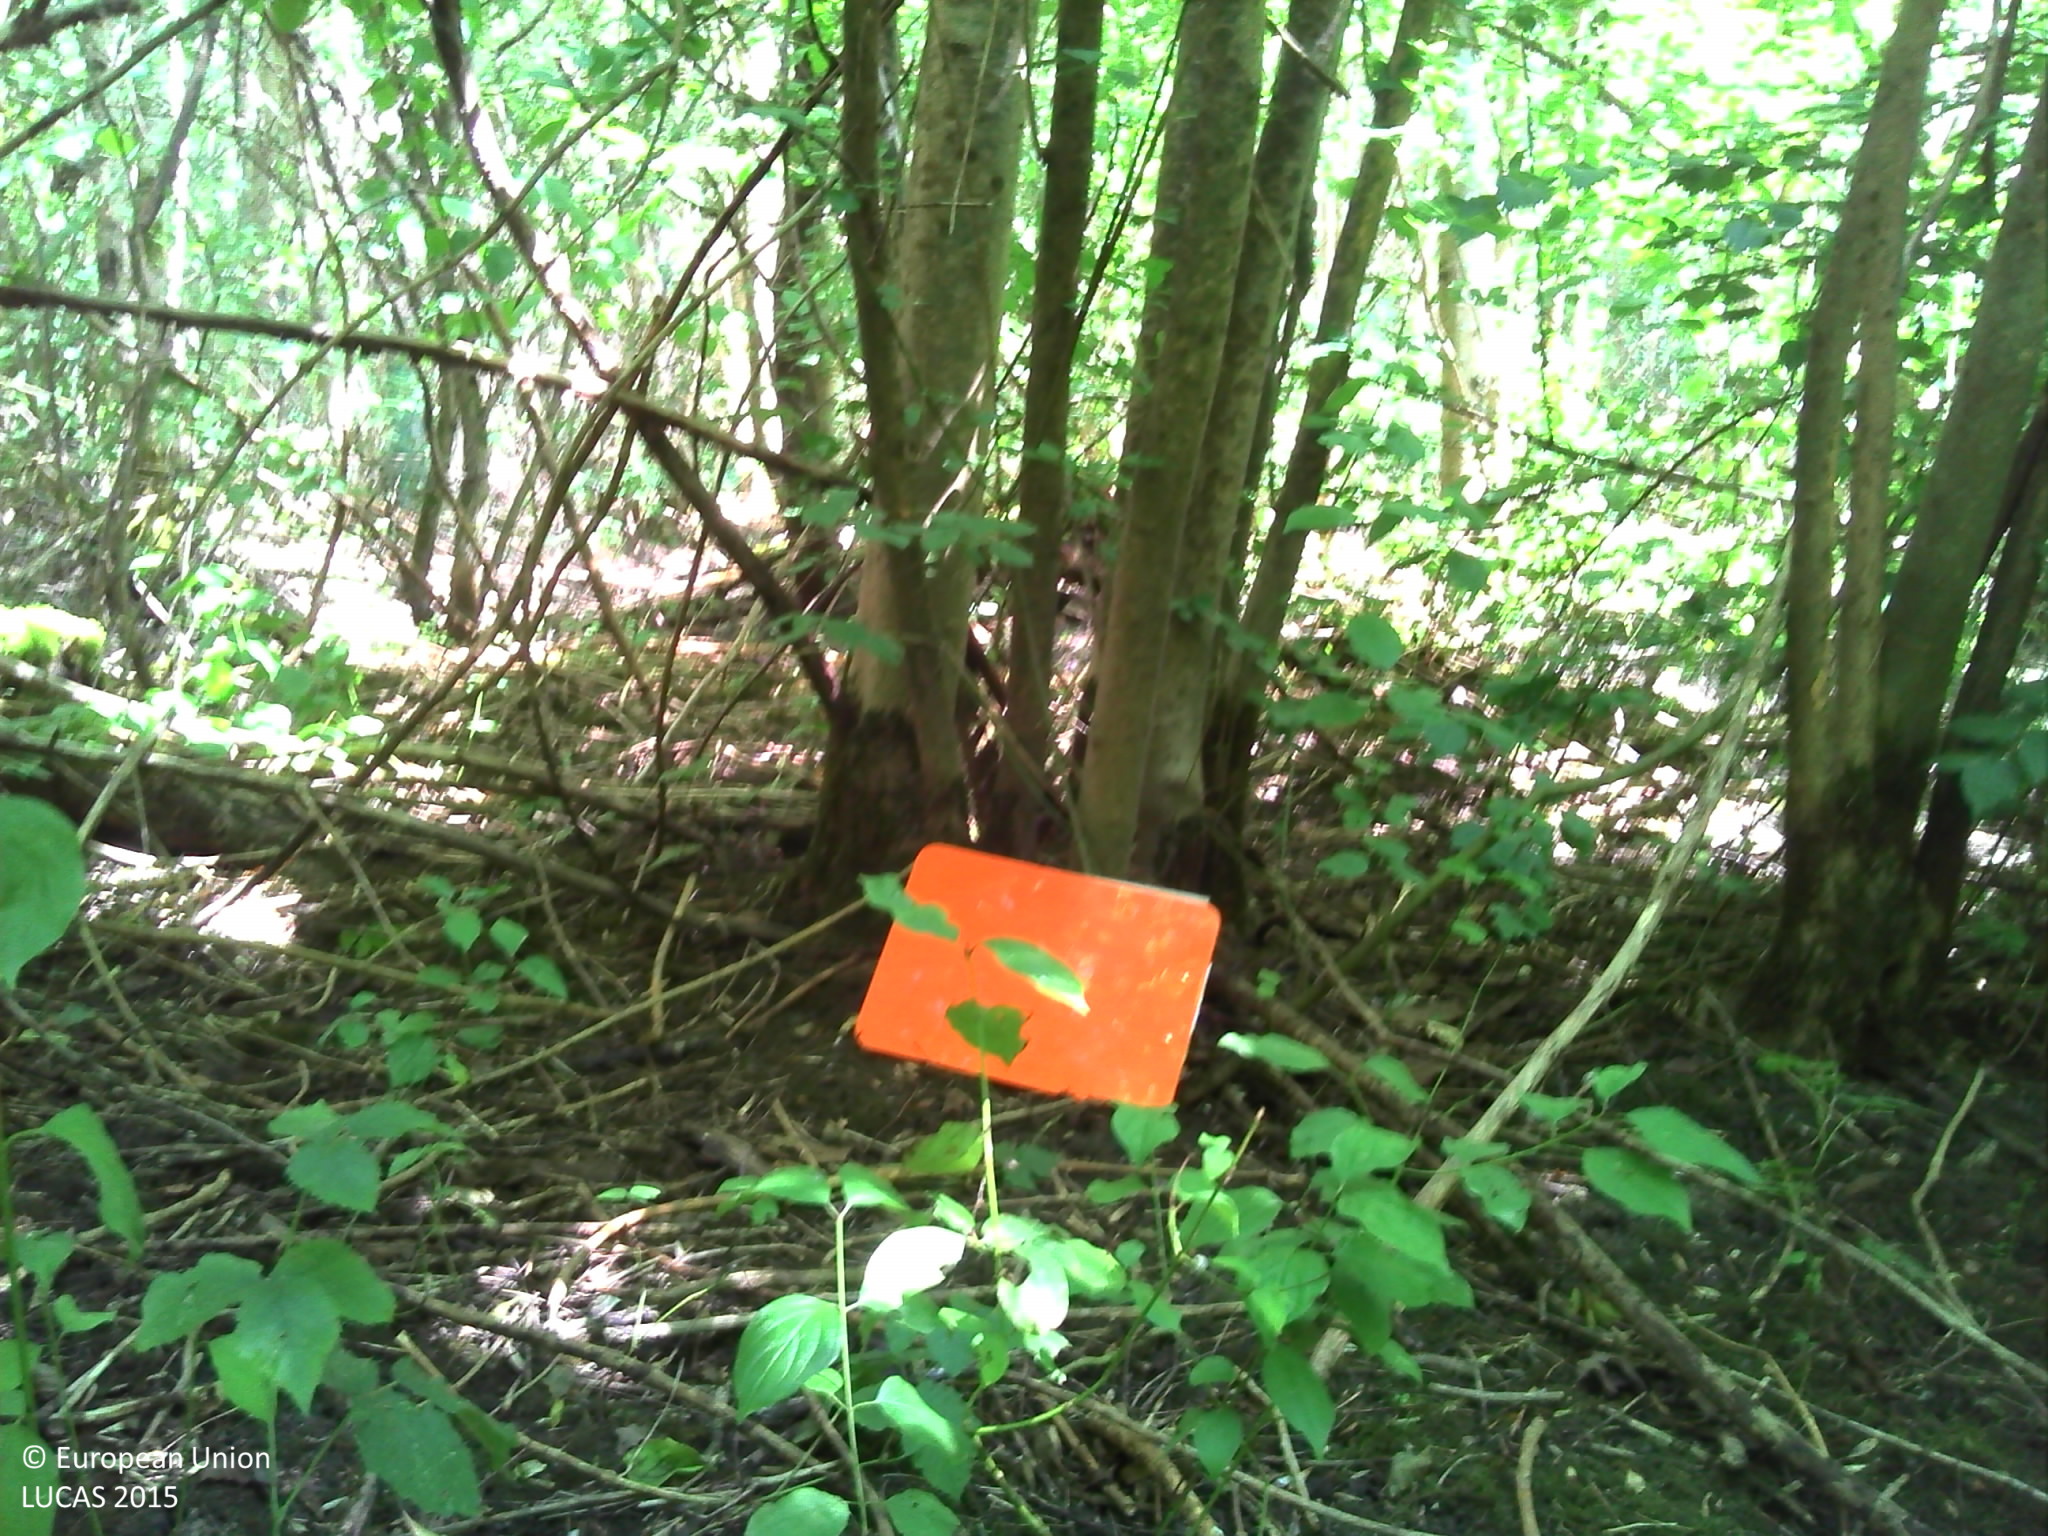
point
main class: Woodland
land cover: Broadleaved woodland
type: acidophilous oak and oak-birch forest
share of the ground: > 75 %
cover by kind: broadleaved forest trees 50 %, herbaceous plants 25 %, lichens and mosses 10 %, unconsolidated bare surface 10 %
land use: Forestry
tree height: > 5 m
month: July
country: FR
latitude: 48.5366
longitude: 3.8057
